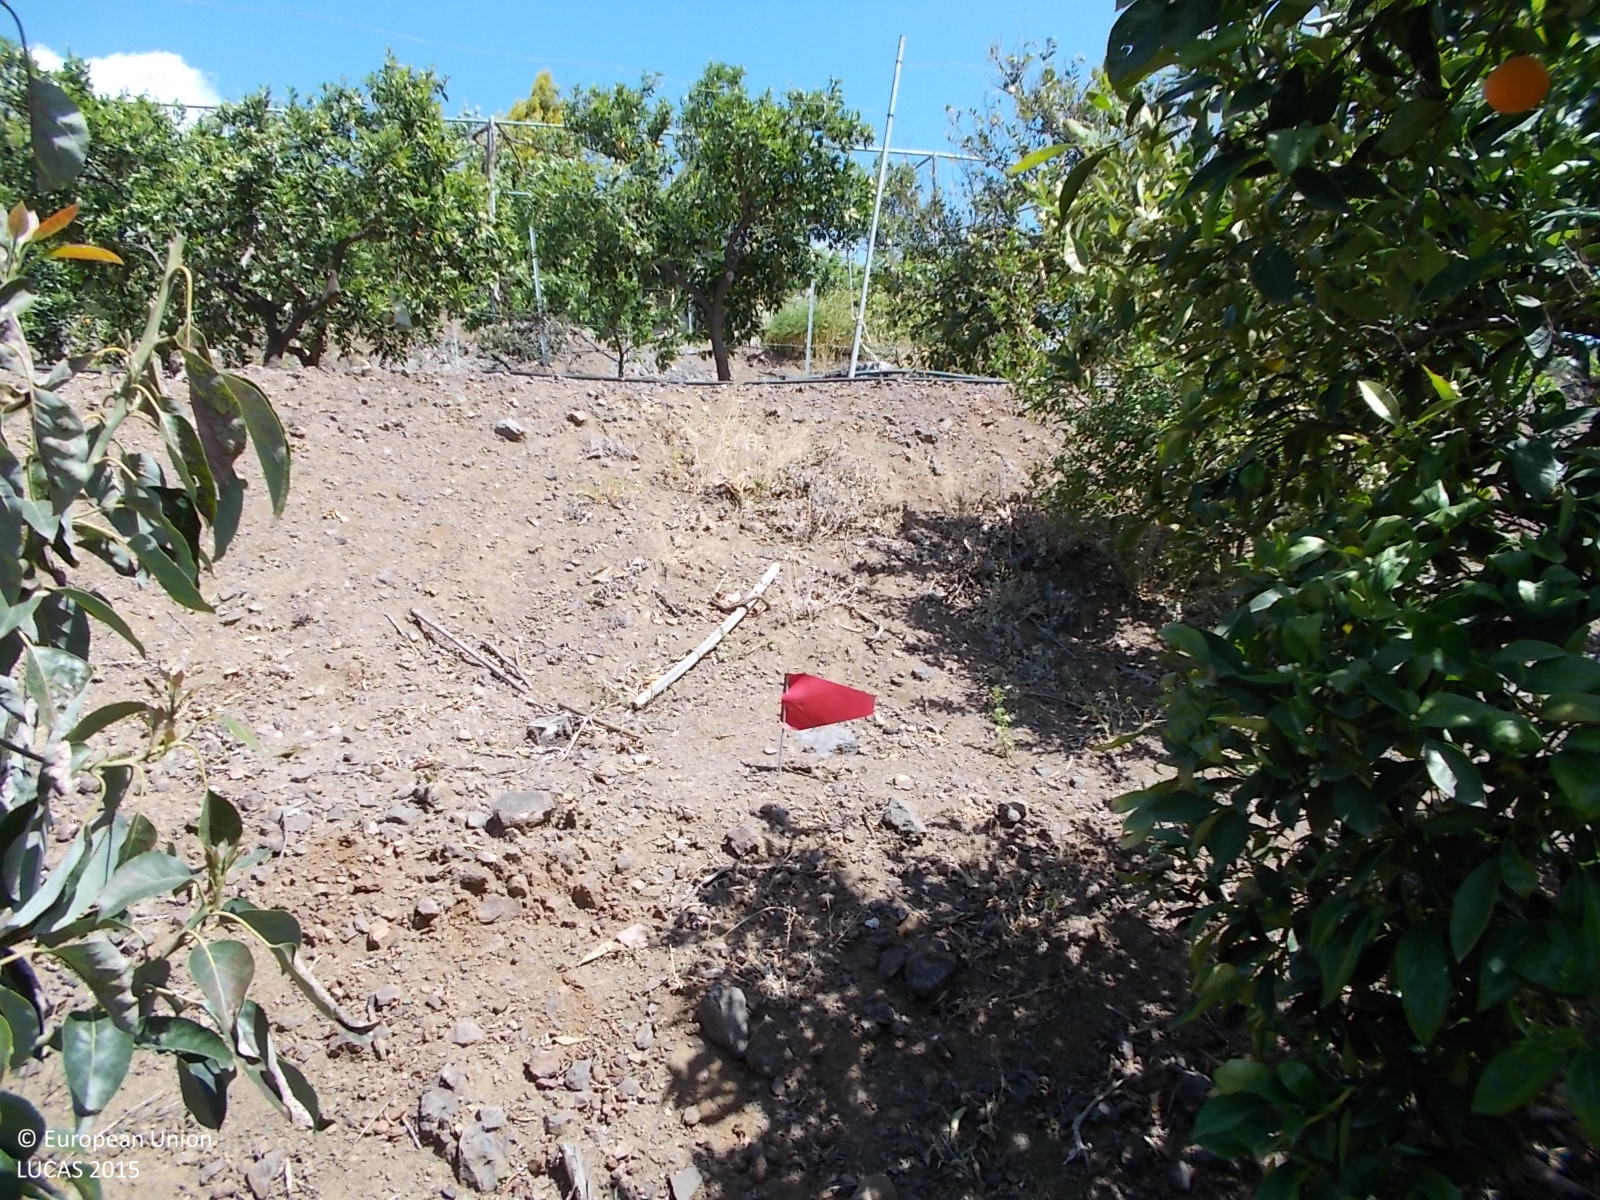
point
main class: Cropland
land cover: Other citrus fruit
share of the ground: > 75 %
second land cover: Other bare soil
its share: > 75 %
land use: Agriculture (excluding fallow land and kitchen gardens)
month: April
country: CY
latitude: 34.8475
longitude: 33.0840
